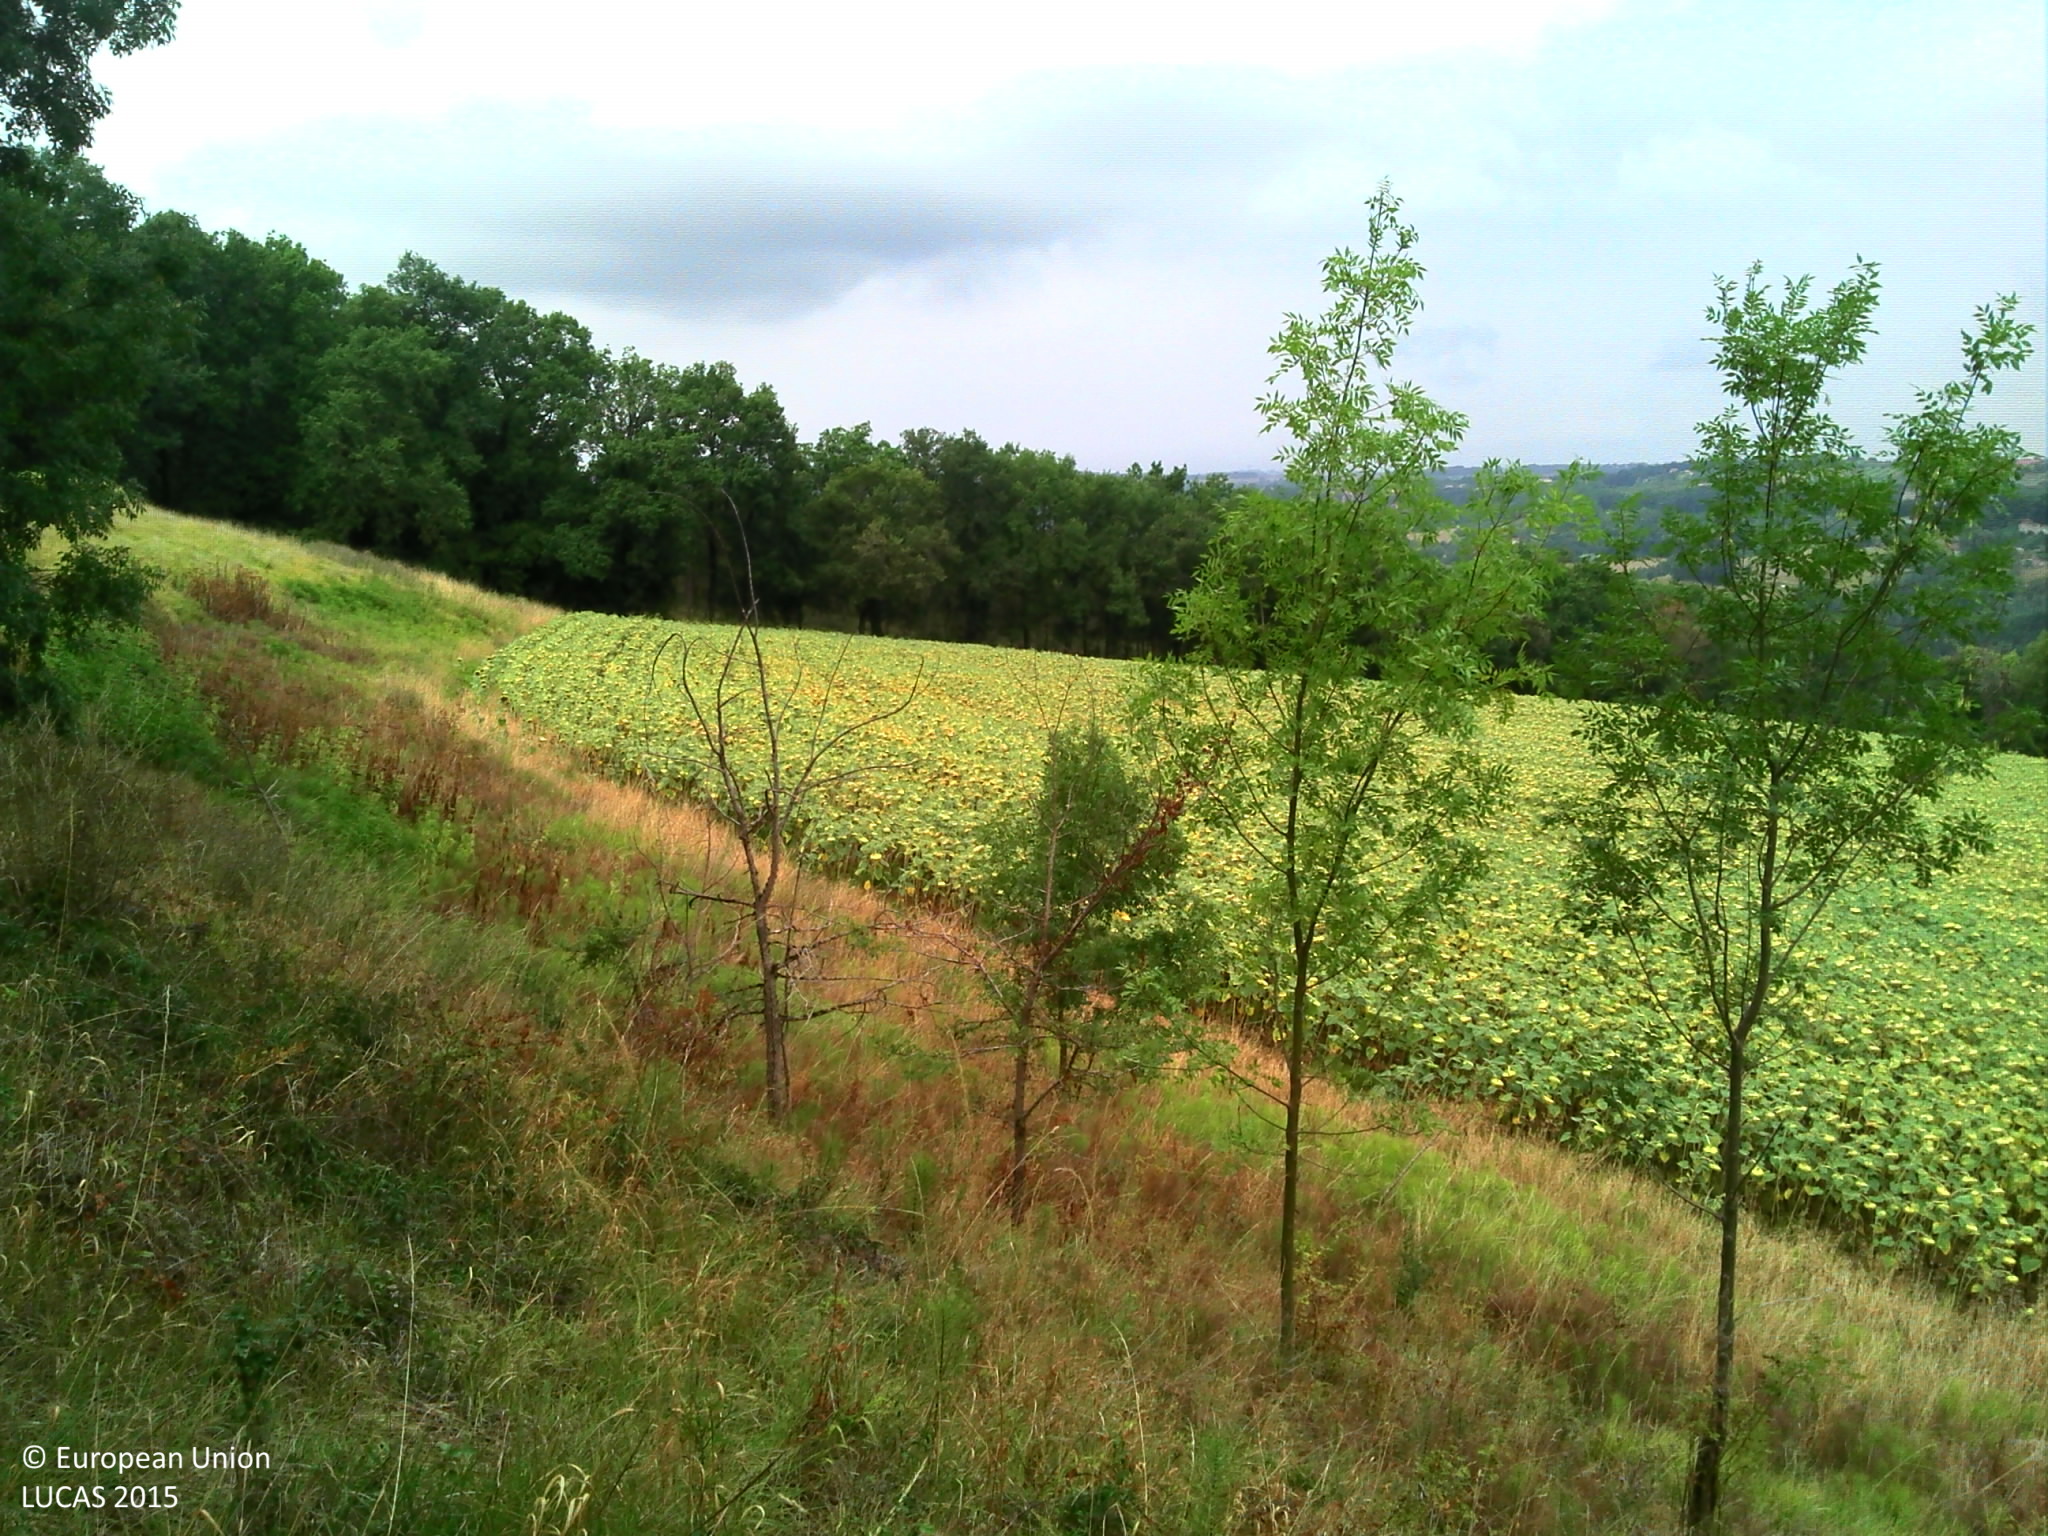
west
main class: Woodland
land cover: Broadleaved woodland
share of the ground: > 75 %
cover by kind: broadleaved forest trees 75 %, herbaceous plants 20 %, shrubs 5 %
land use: Semi-natural and natural areas not in use
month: August
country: FR
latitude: 44.2487
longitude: 0.5892
